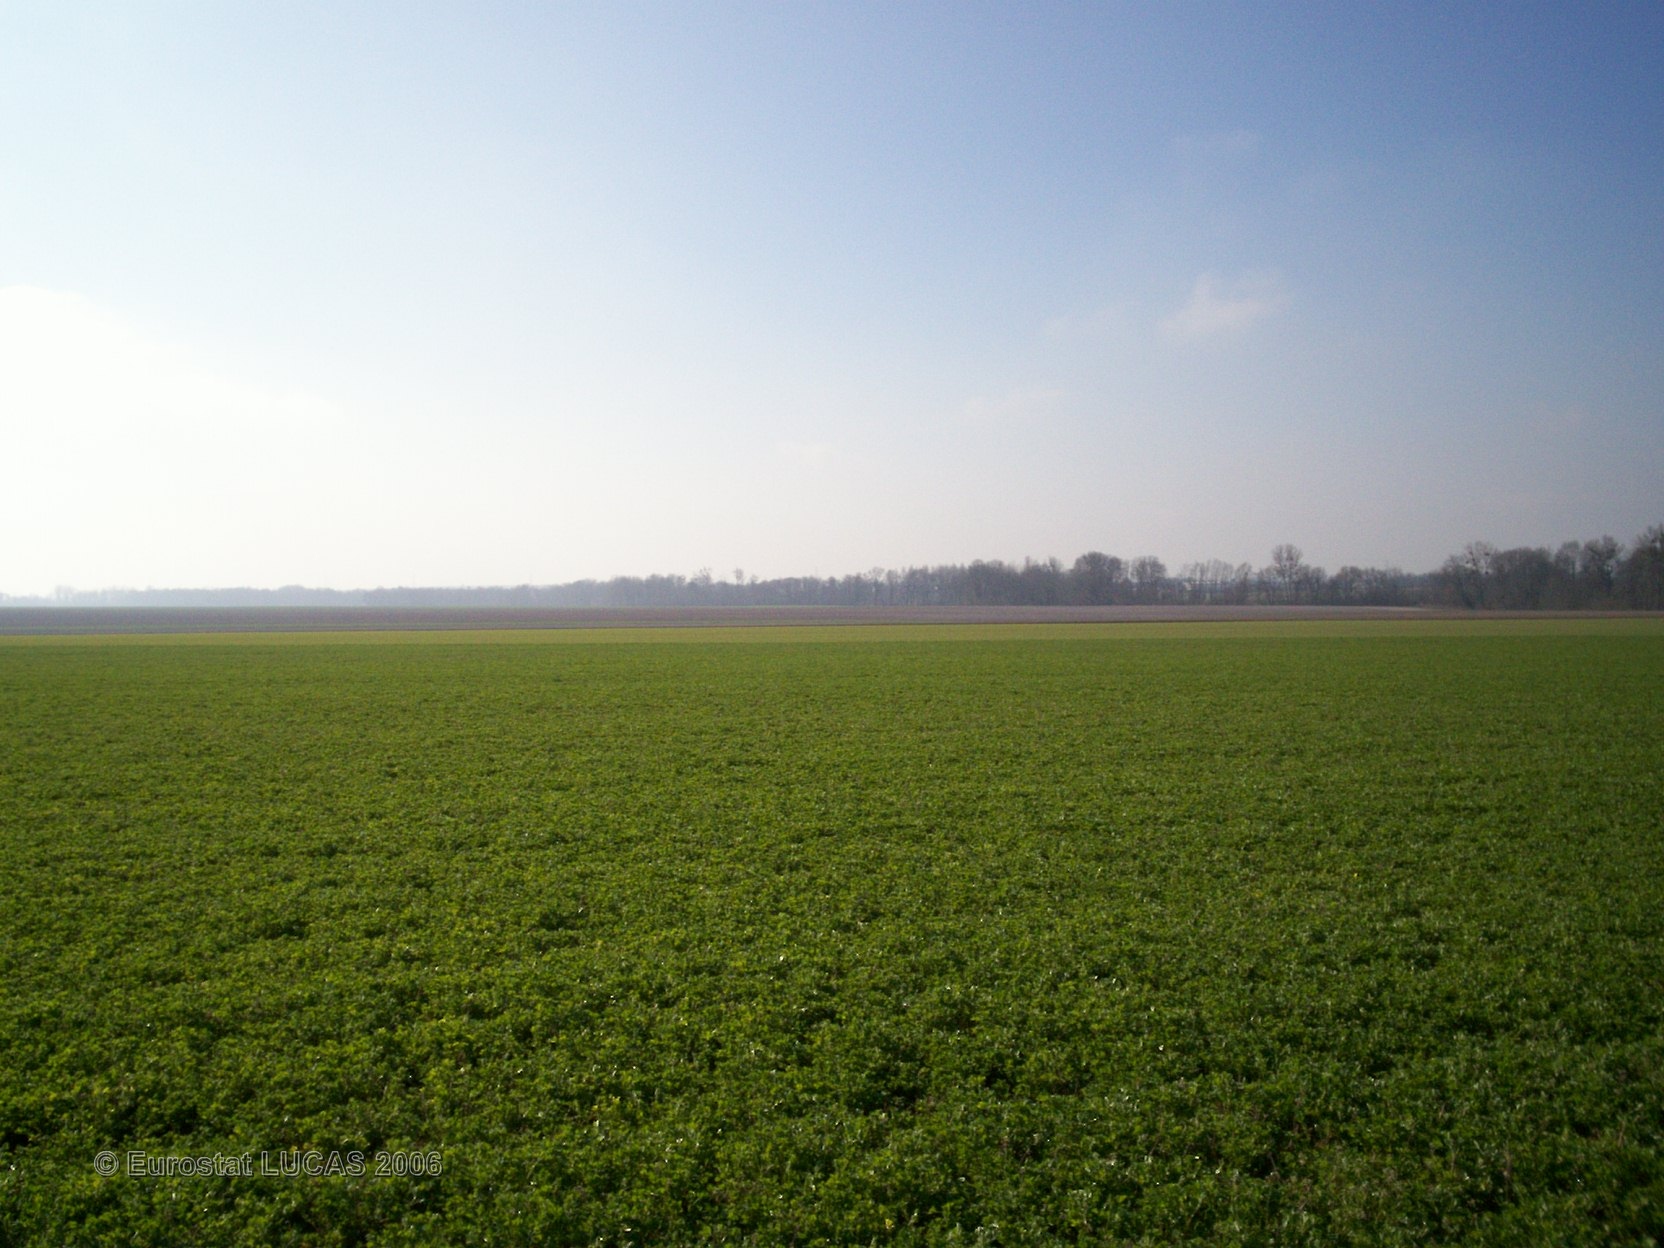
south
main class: Cropland
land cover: Lucerne
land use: Agriculture (excluding fallow land and kitchen gardens)
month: April
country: FR
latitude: 49.0896
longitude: 4.3682
